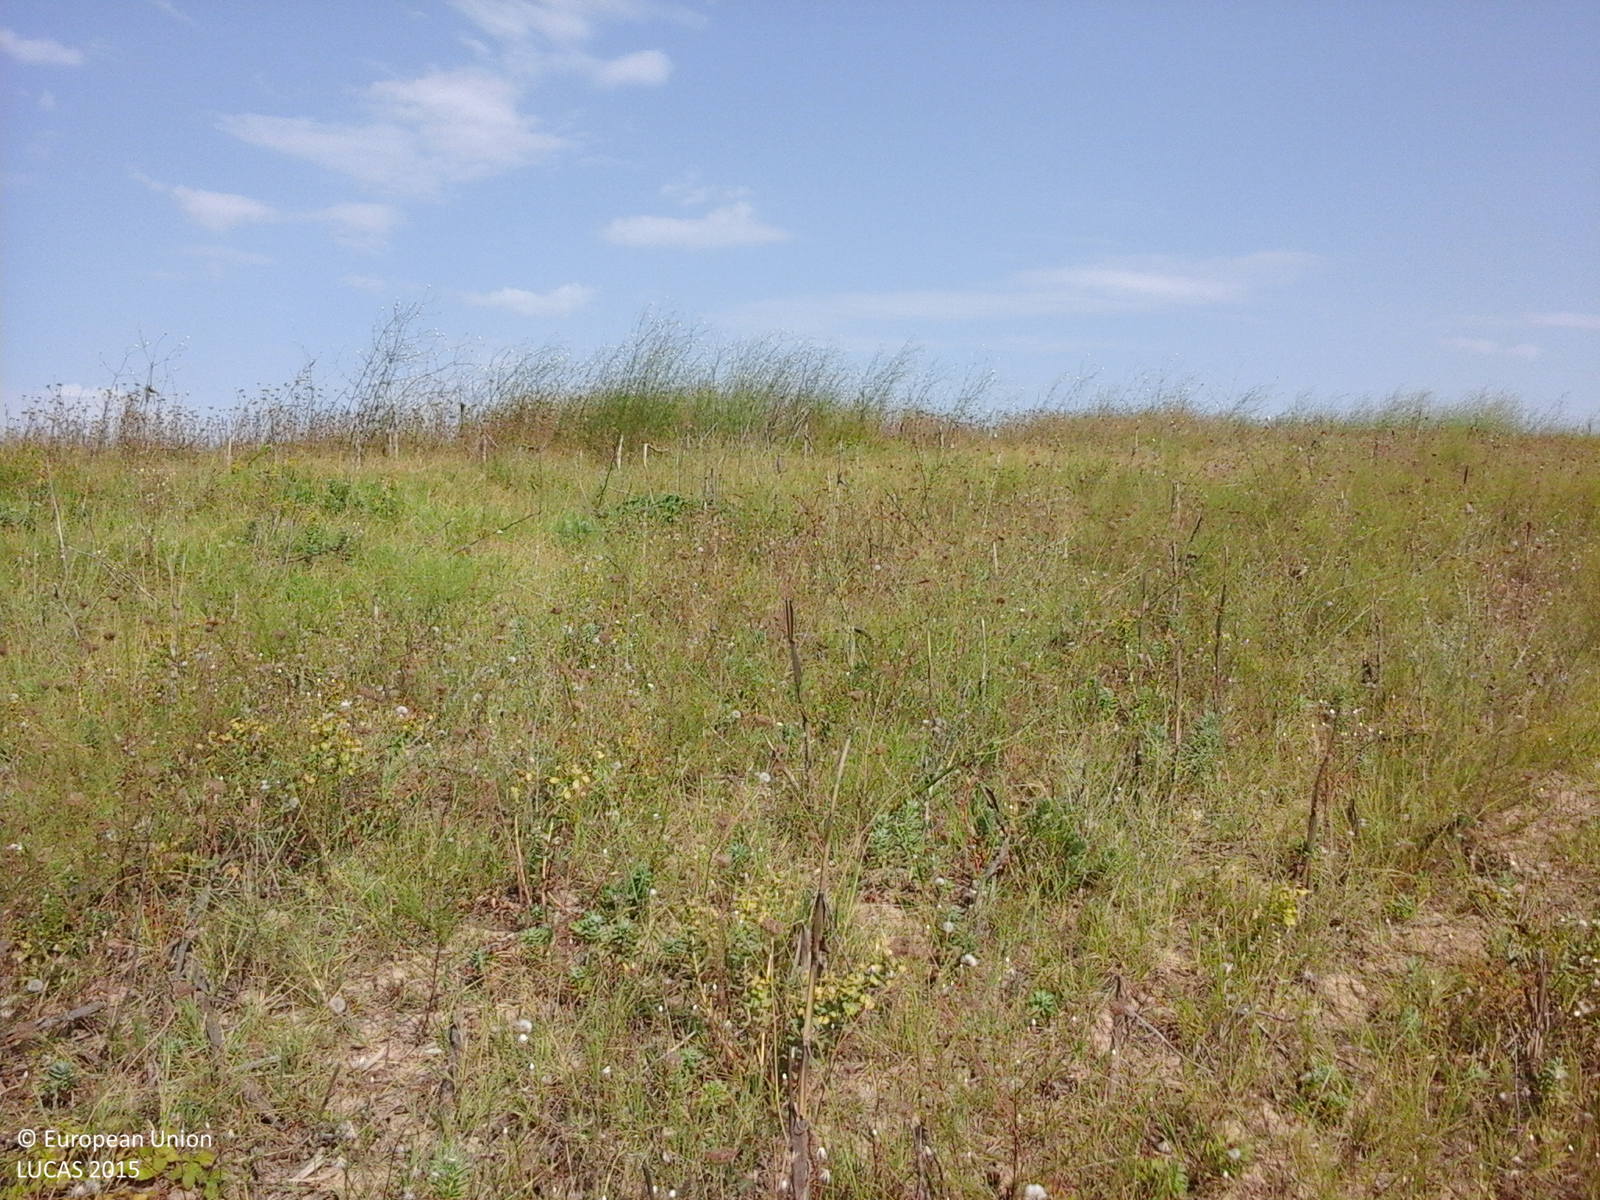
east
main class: Grassland
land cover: Spontaneously vegetated surfaces
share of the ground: 10 - 25 %
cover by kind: herbaceous plants 100 %
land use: Fallow land
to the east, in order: Spontaneously vegetated surfaces; Maize; Grassland with sparse tree/shrub cover; Maize
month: August
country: RO
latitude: 44.1886
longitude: 27.9554
